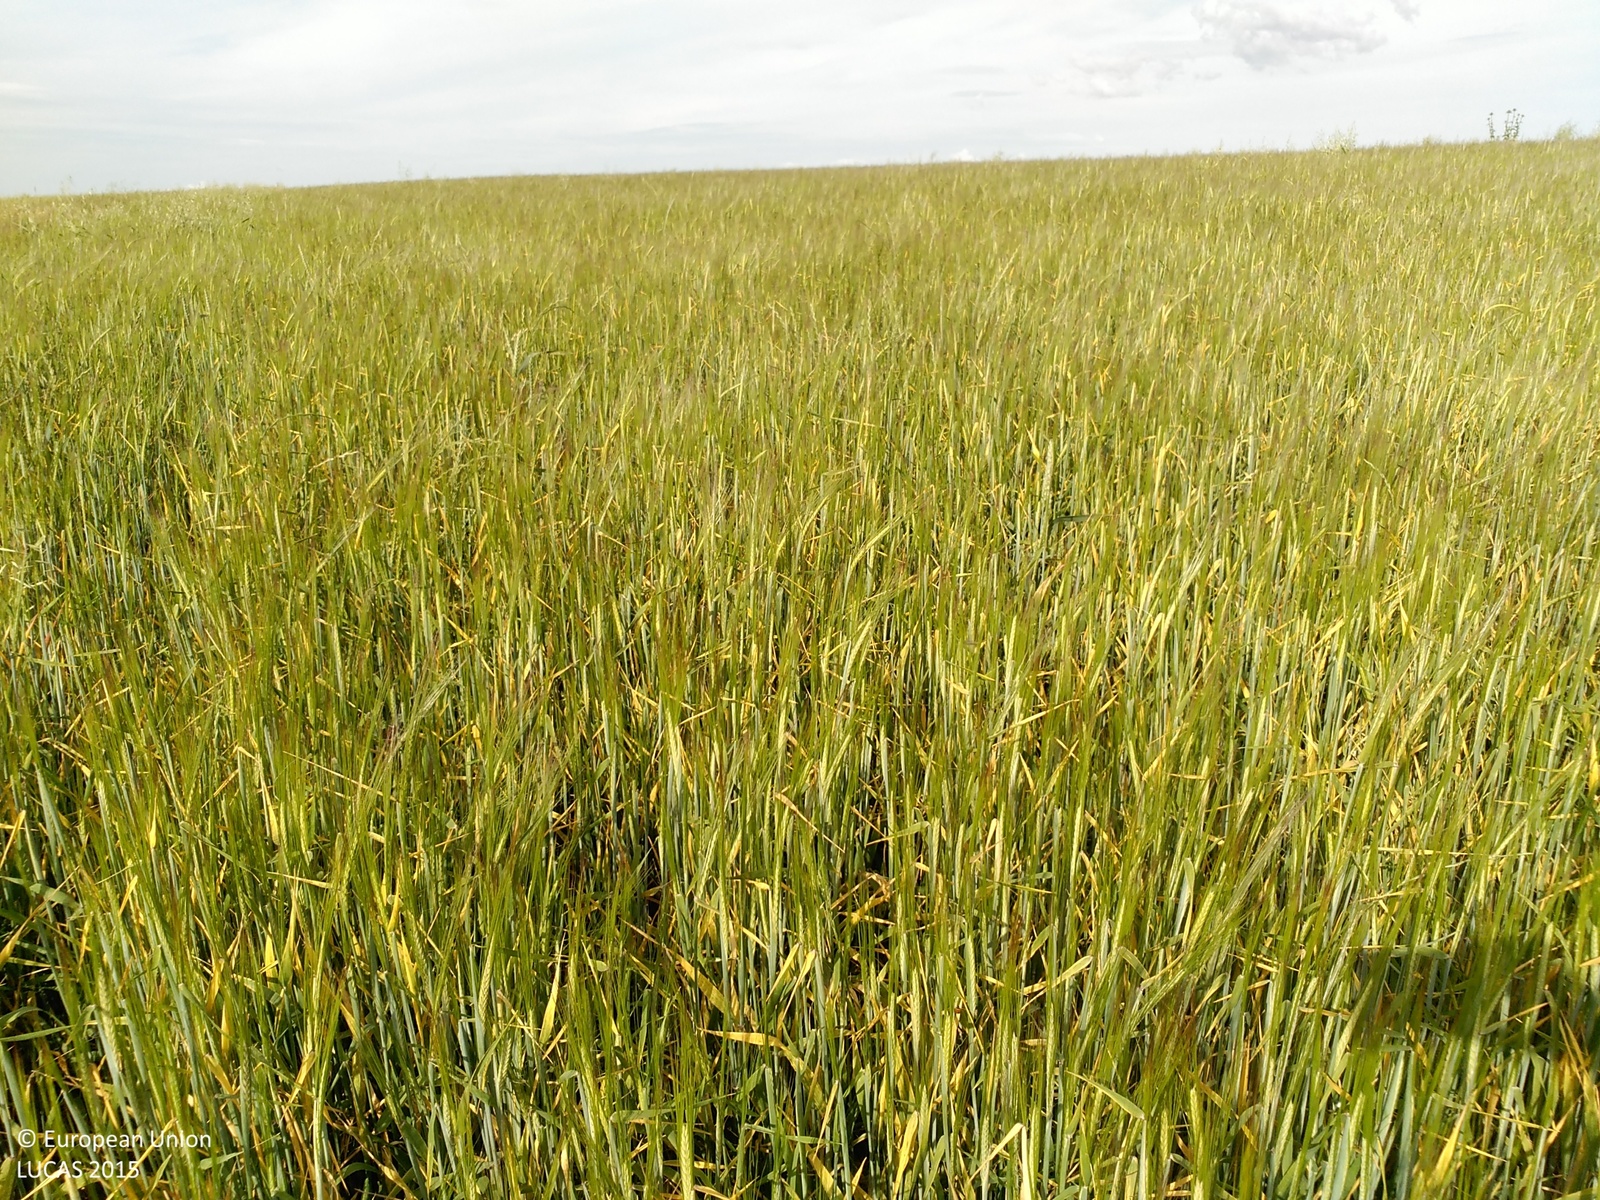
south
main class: Cropland
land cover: Barley
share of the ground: > 75 %
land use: Agriculture (excluding fallow land and kitchen gardens)
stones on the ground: < 10 %
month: May
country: ES
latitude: 39.7638
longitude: -4.6688
